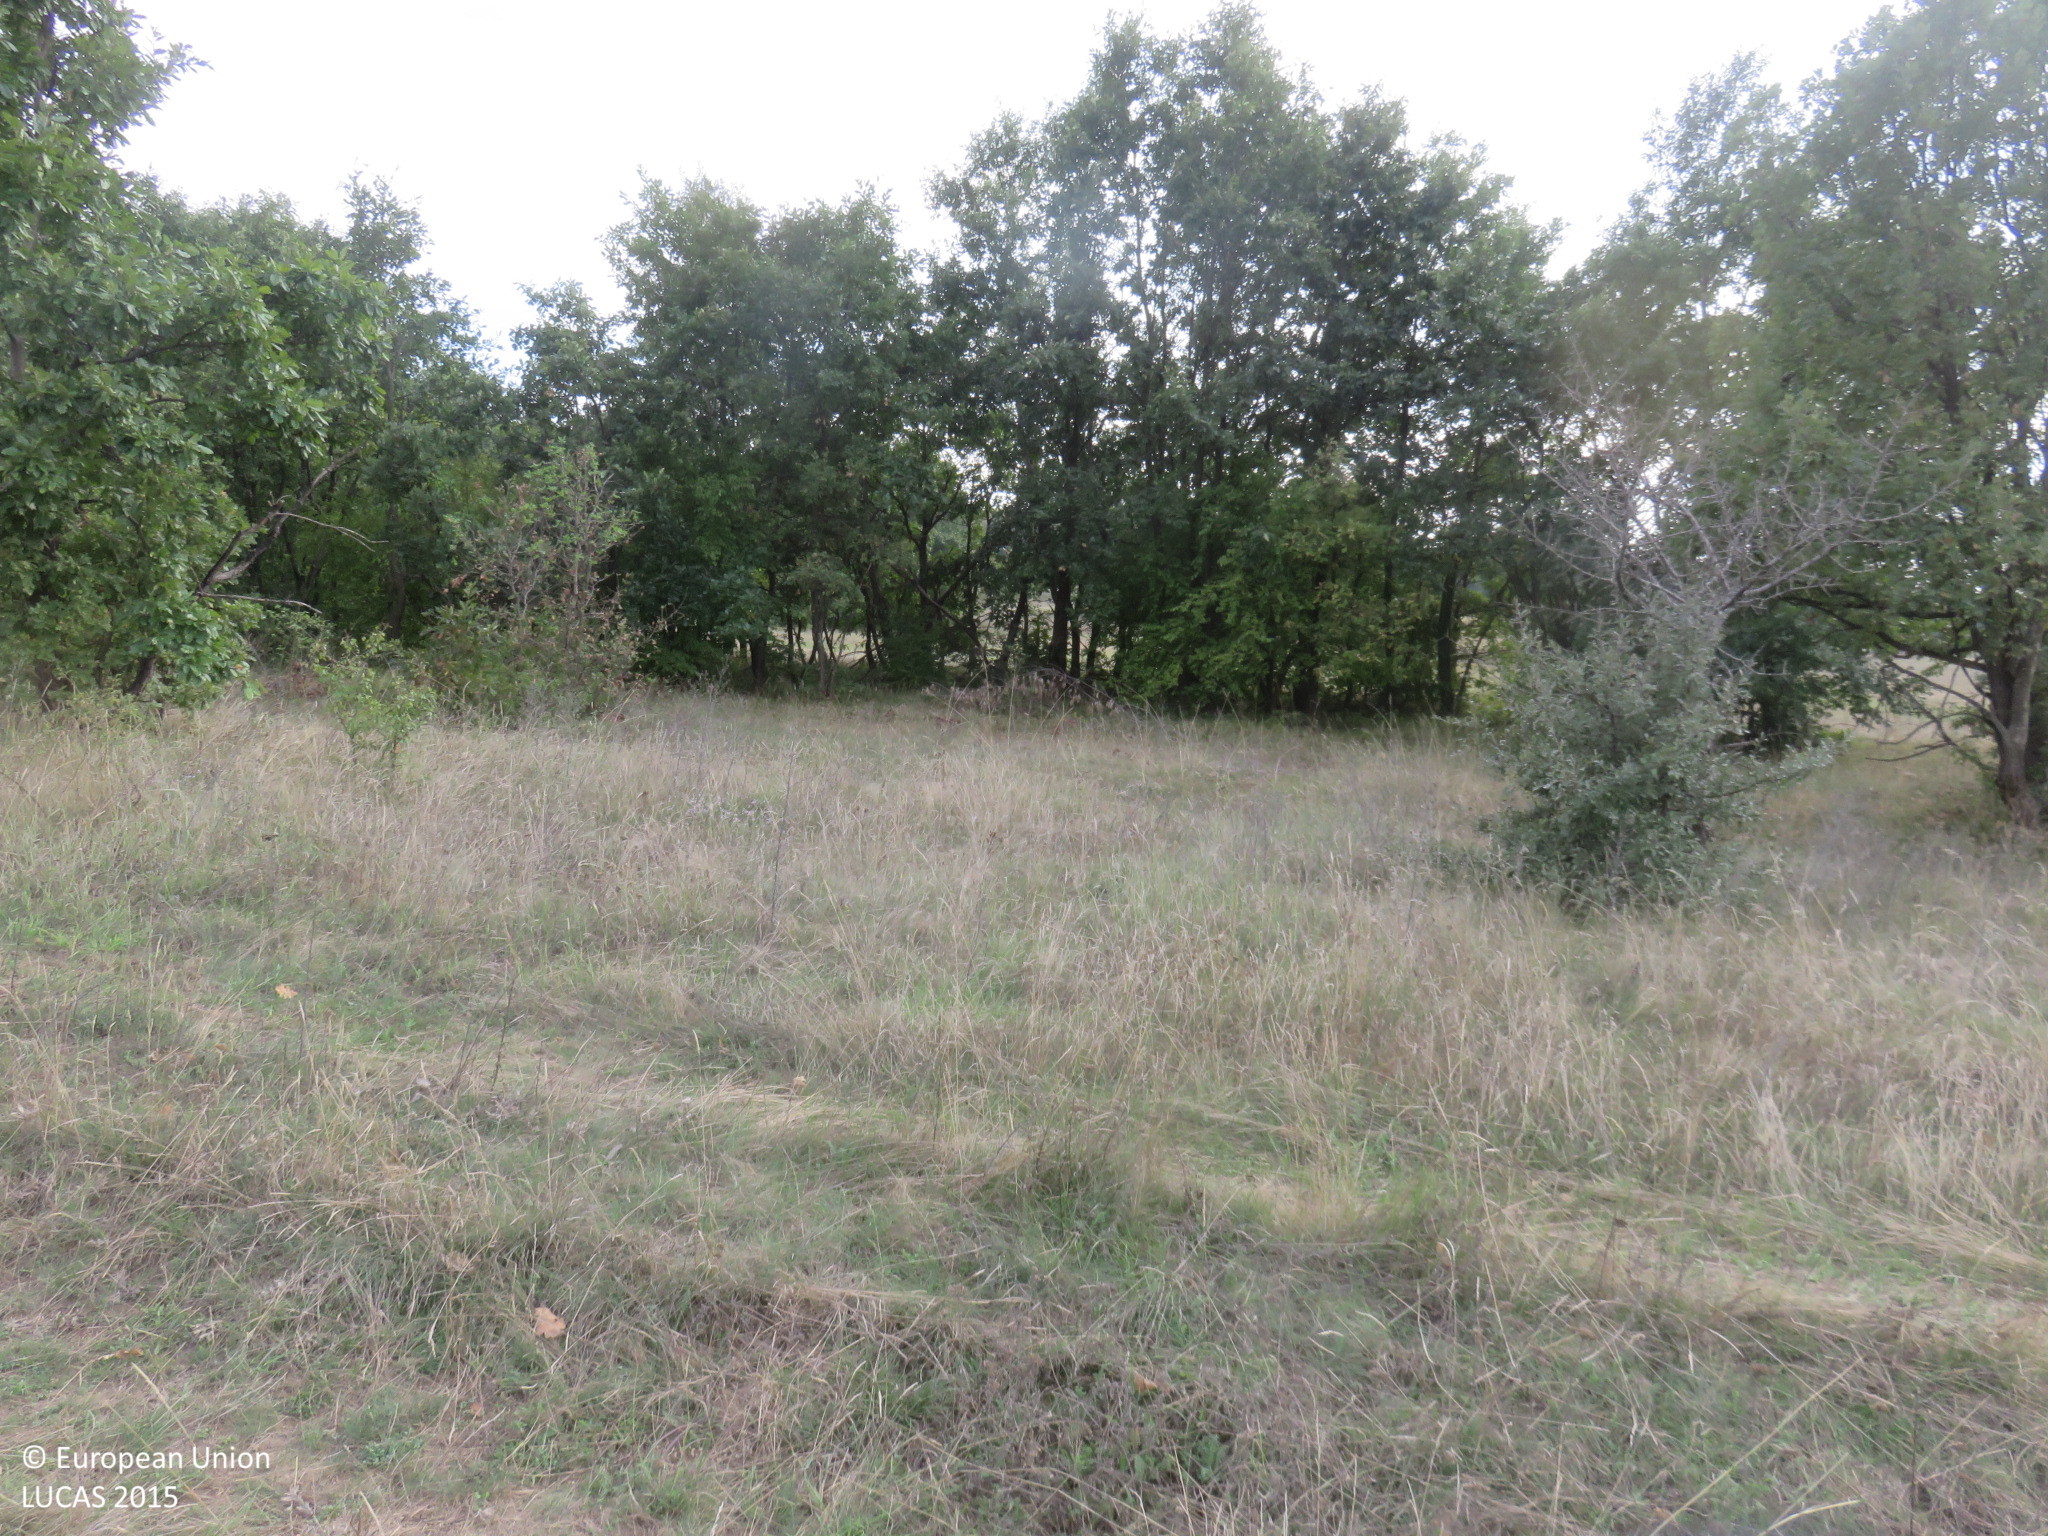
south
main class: Cropland
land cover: Common wheat
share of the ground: < 10 %
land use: Agriculture (excluding fallow land and kitchen gardens)
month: September
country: BG
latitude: 43.1564
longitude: 24.9094
